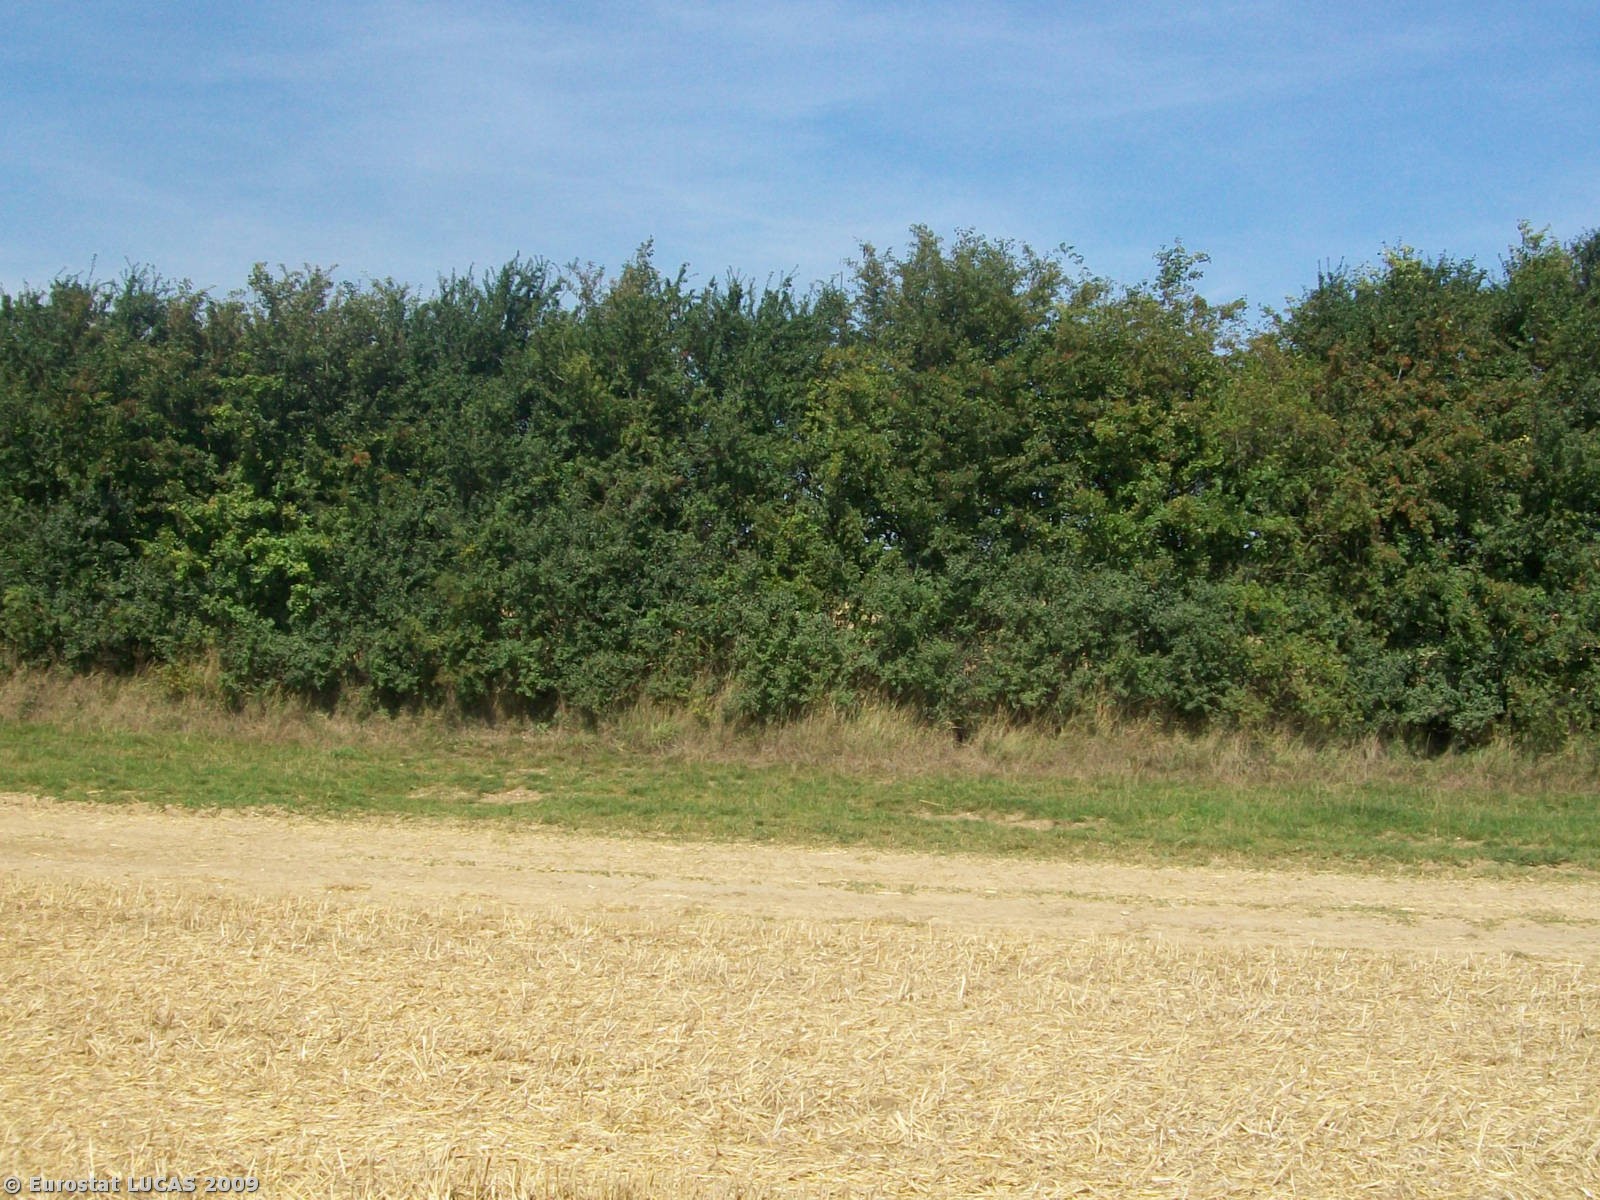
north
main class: Cropland
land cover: Common wheat
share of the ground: < 10 %
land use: Agriculture (excluding fallow land and kitchen gardens)
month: August
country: GB
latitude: 51.9260
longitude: 0.0943
